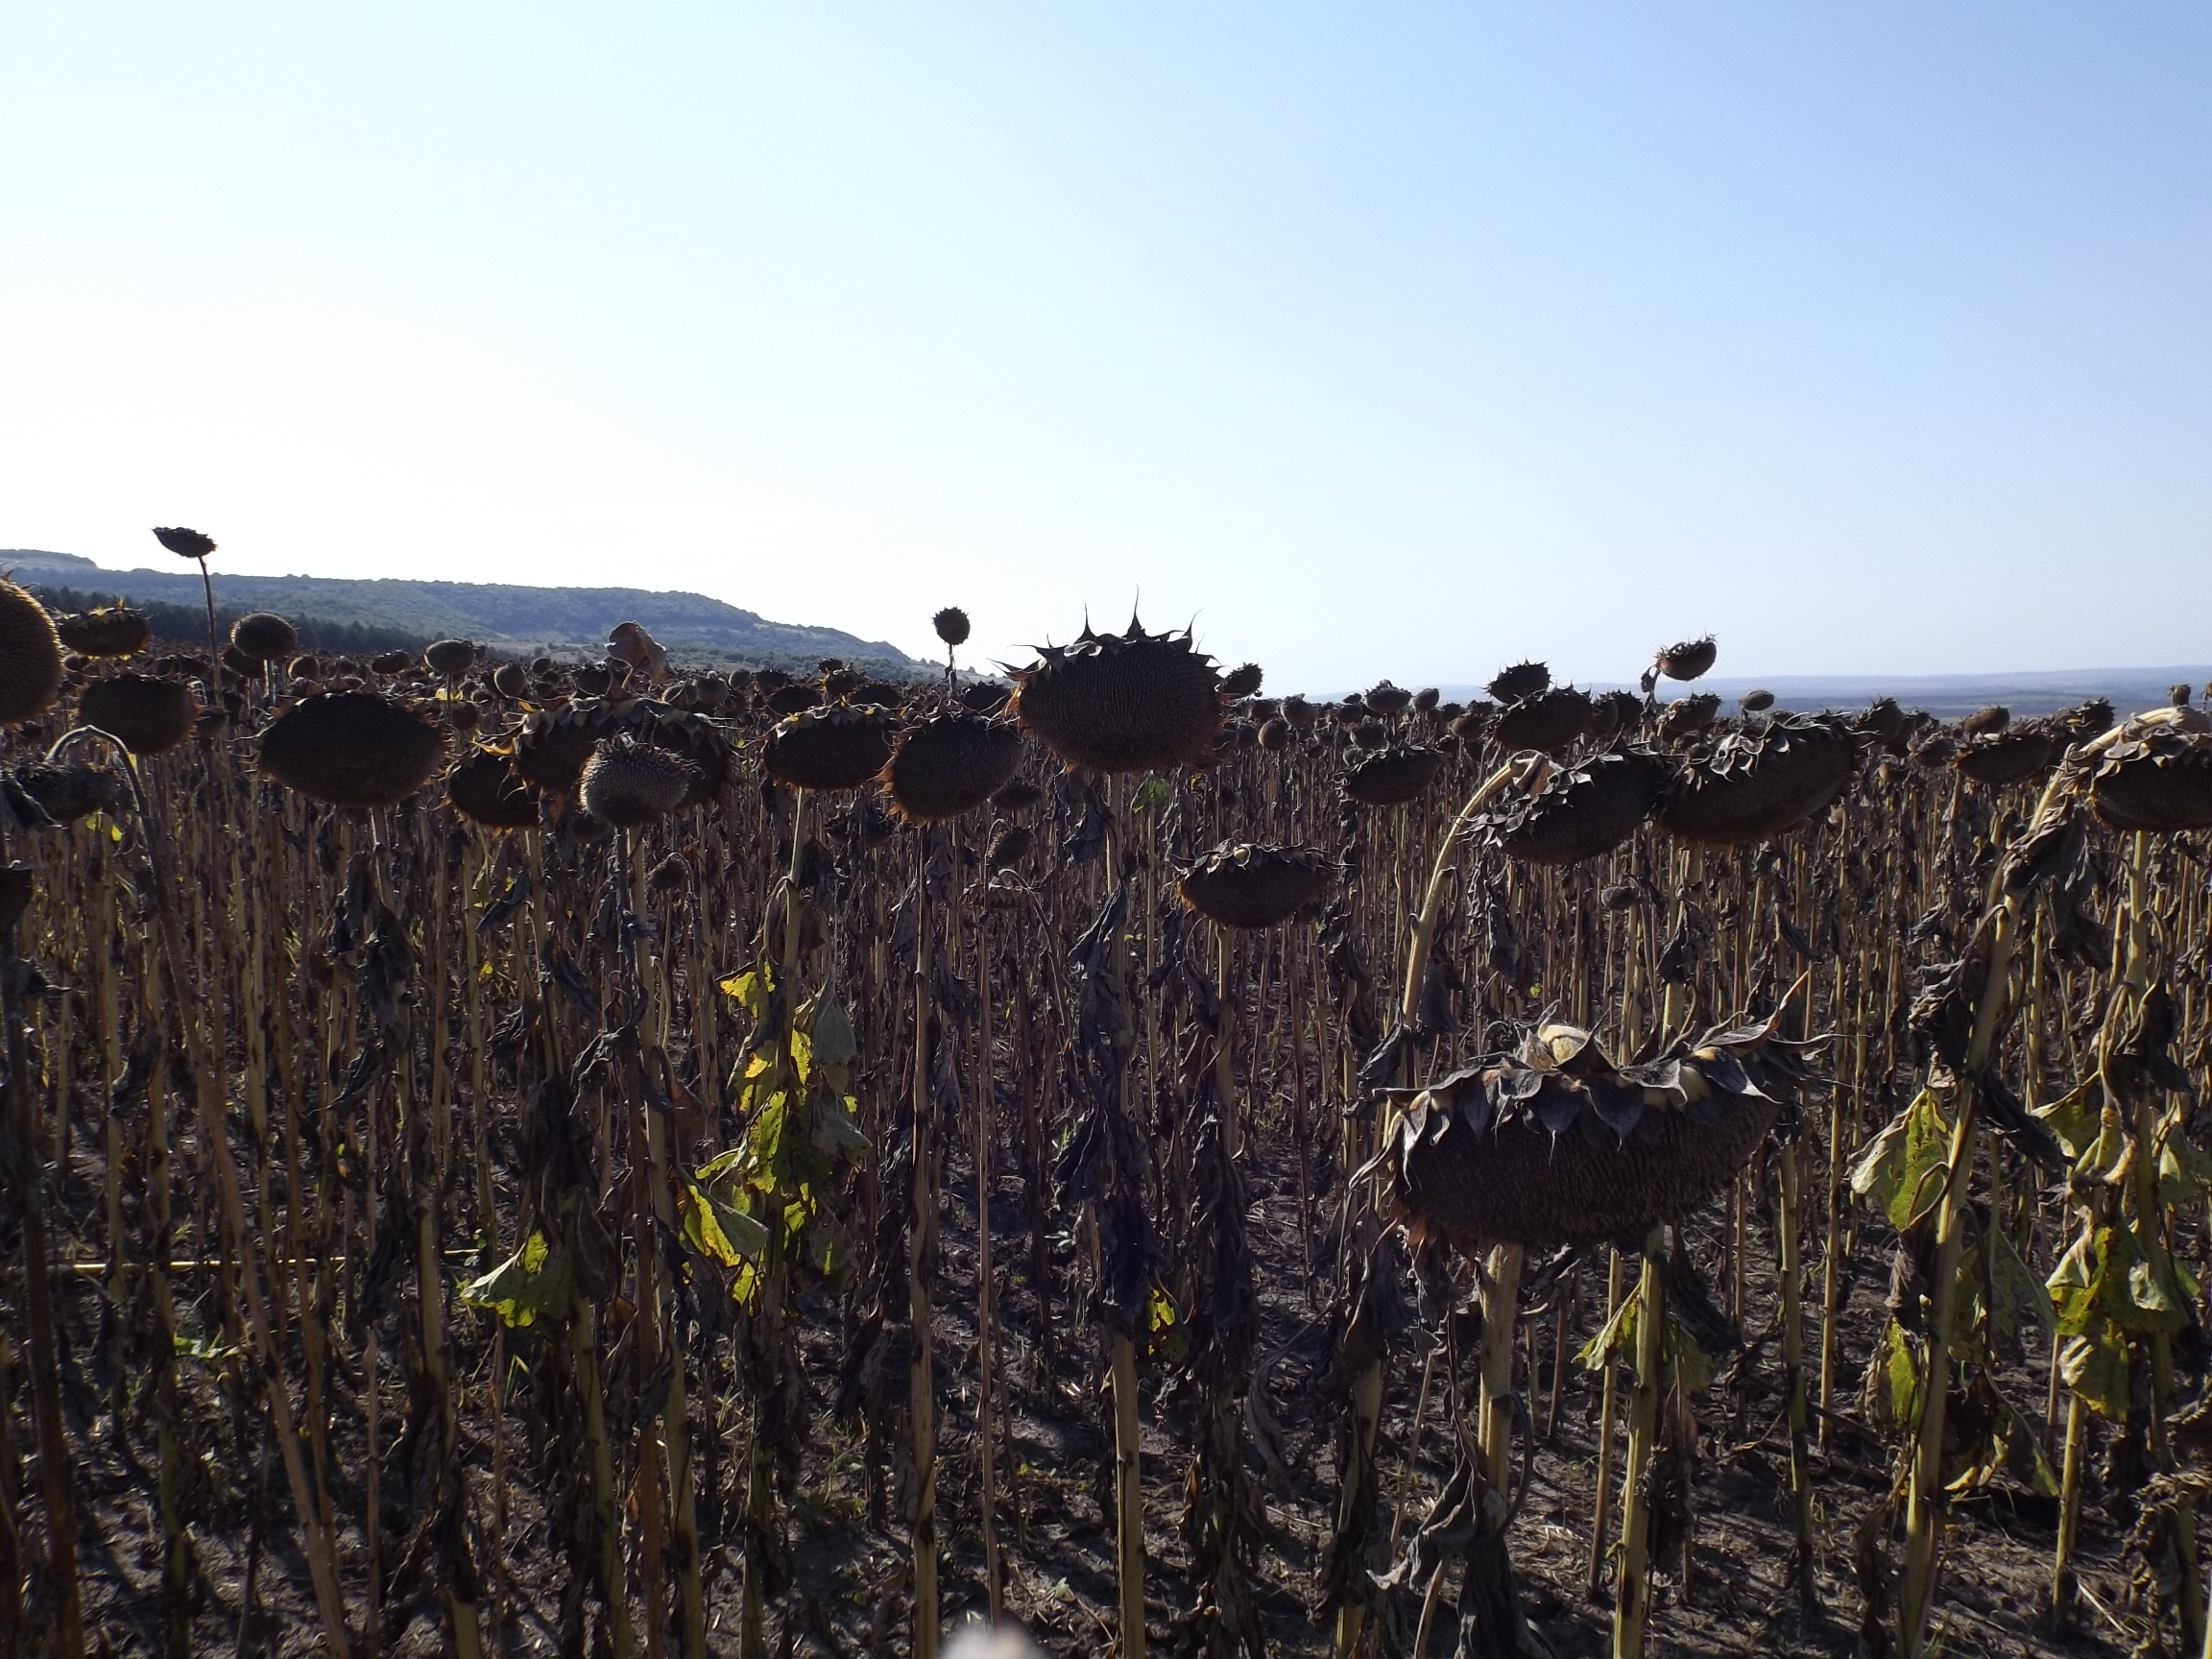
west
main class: Cropland
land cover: Sunflower
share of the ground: > 75 %
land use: Agriculture (excluding fallow land and kitchen gardens)
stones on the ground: < 10 %
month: August
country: BG
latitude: 43.1040
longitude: 27.4120
